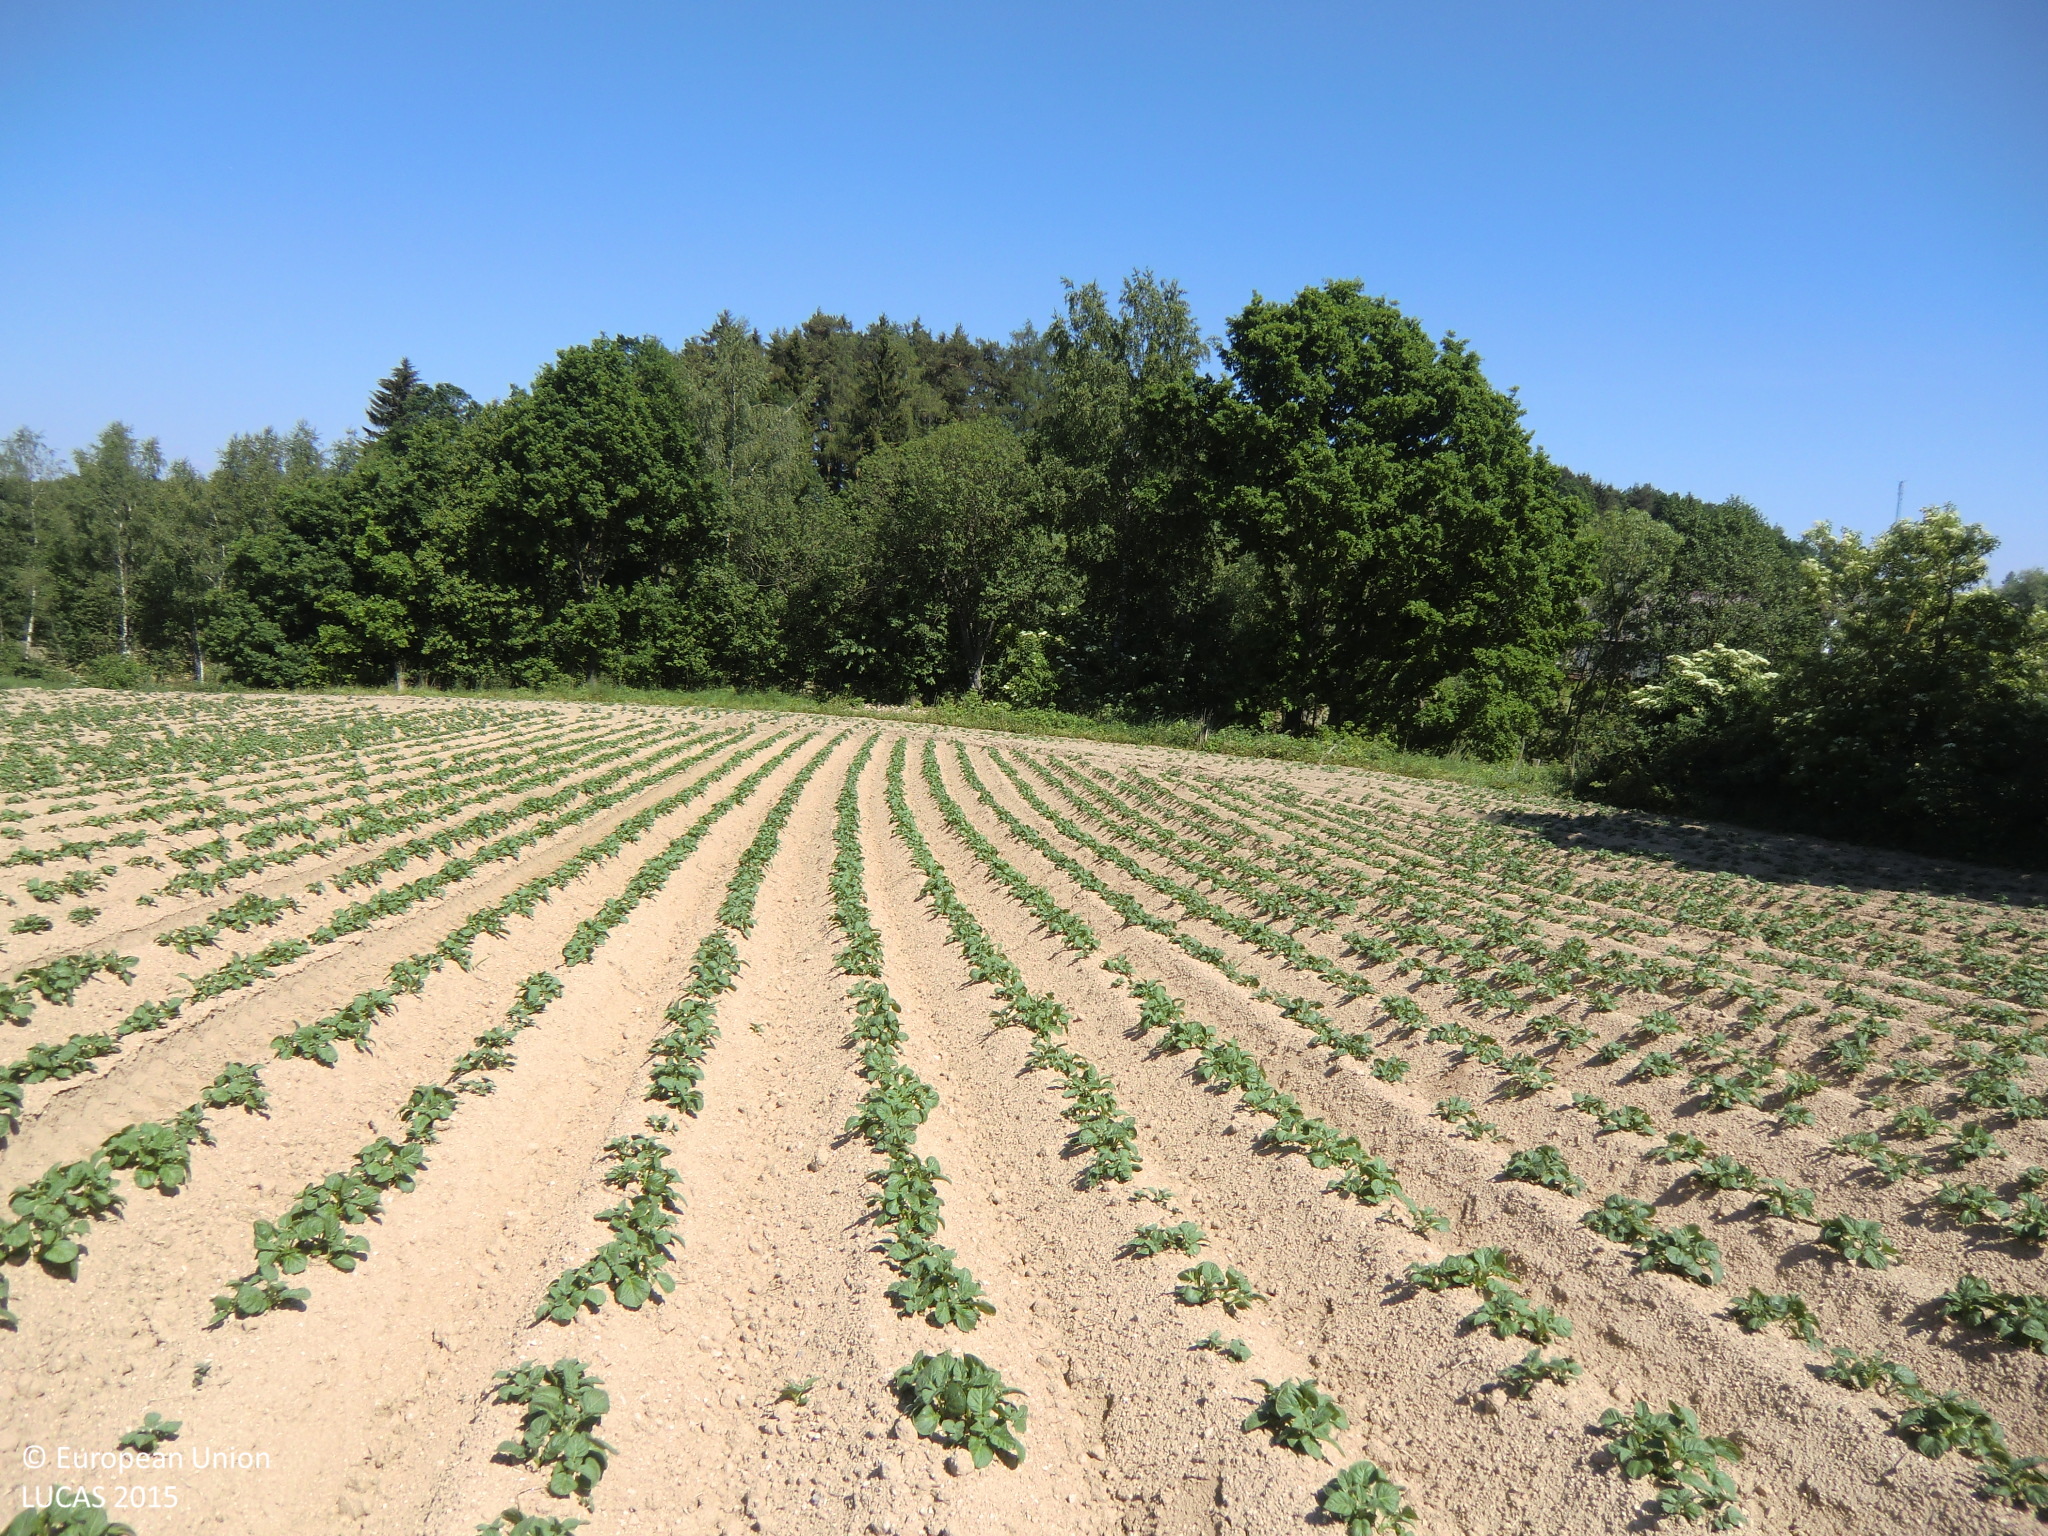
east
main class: Cropland
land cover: Potatoes
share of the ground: 10 - 25 %
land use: Agriculture (excluding fallow land and kitchen gardens)
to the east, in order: Potatoes; Broadleaved woodland; Paved roads, cycling and walking lanes; Grassland without tree/shrub cover; Broadleaved woodland; Rivers and streams; Broadleaved woodland; Grassland without tree/shrub cover; Spruce dominated mixed woodland; Rye; Fences; Grassland without tree/shrub cover; Electric lines; Grassland without tree/shrub cover; Fences; Grassland without tree/shrub cover
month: June
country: AT
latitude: 48.6864
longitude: 15.0142
